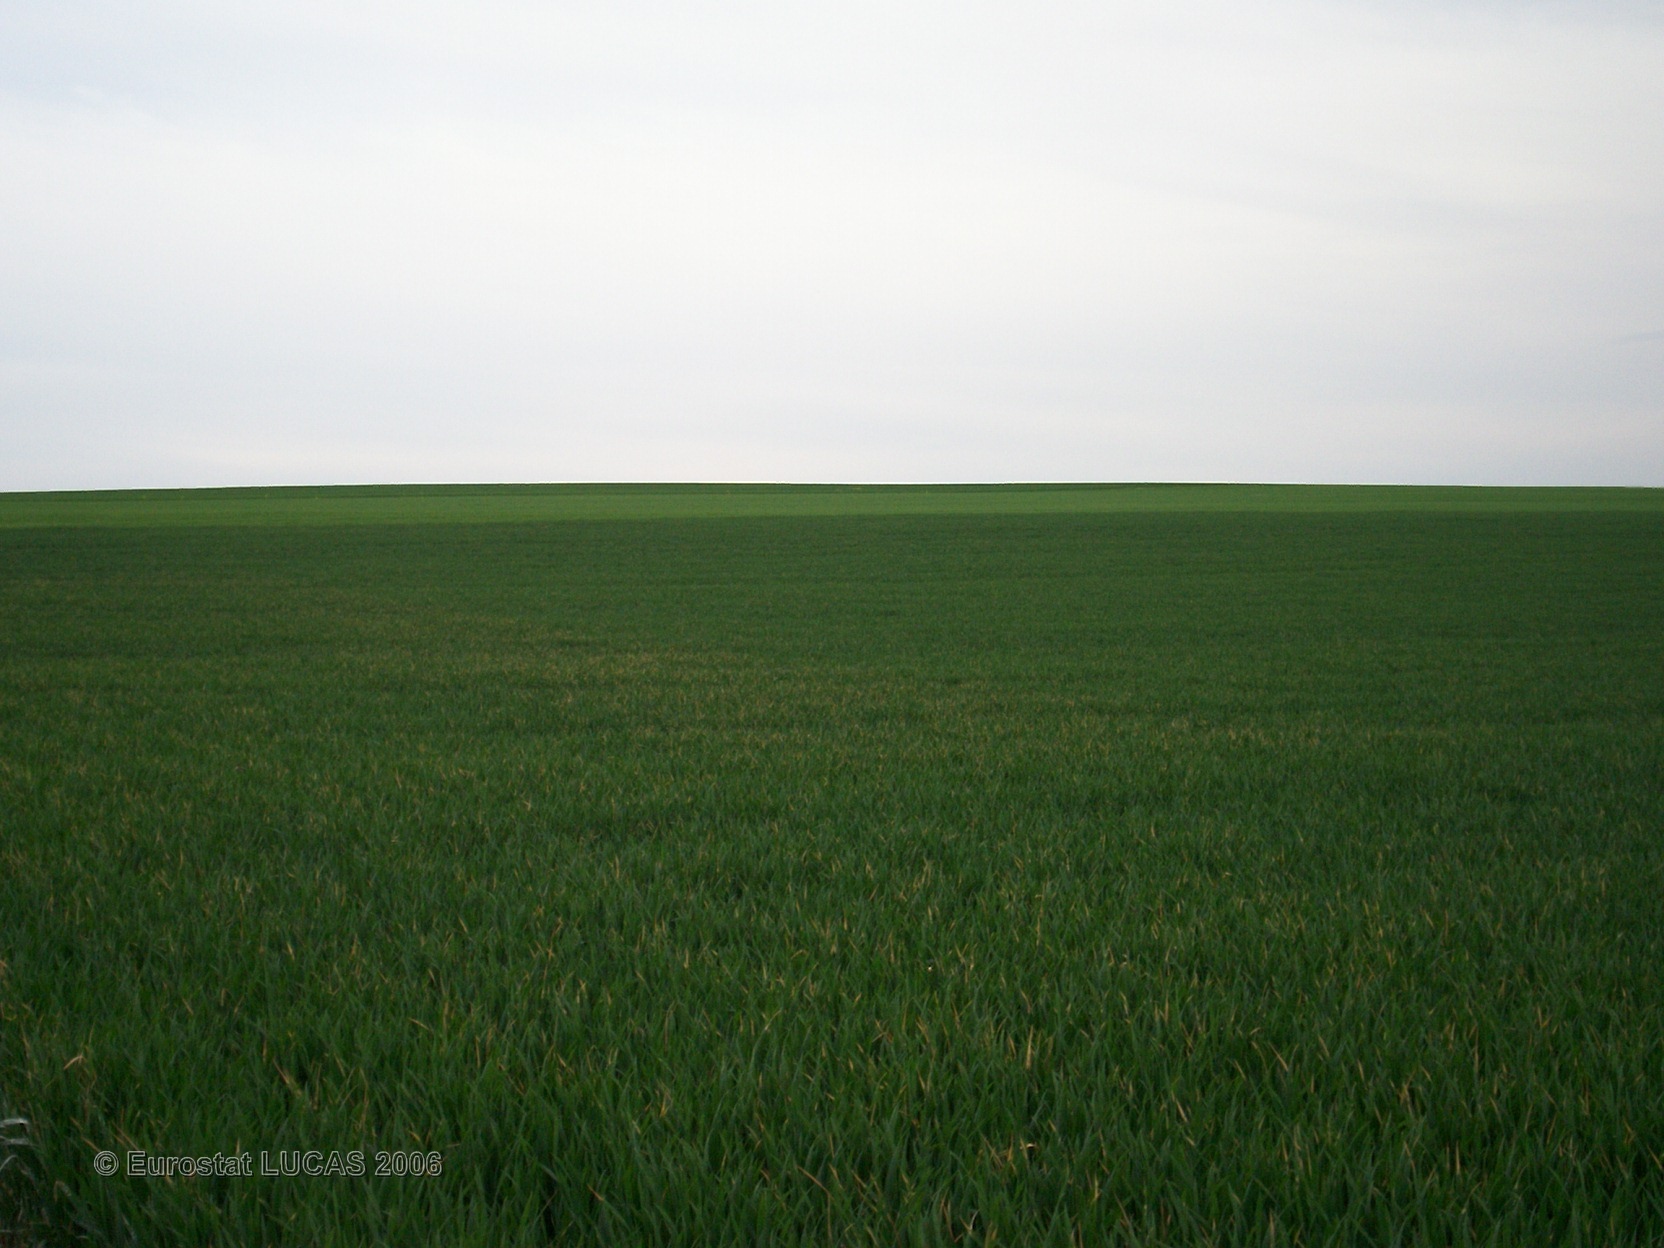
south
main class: Cropland
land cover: Common wheat
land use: Agriculture (excluding fallow land and kitchen gardens)
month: May
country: FR
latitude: 49.5377
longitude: 4.3162
